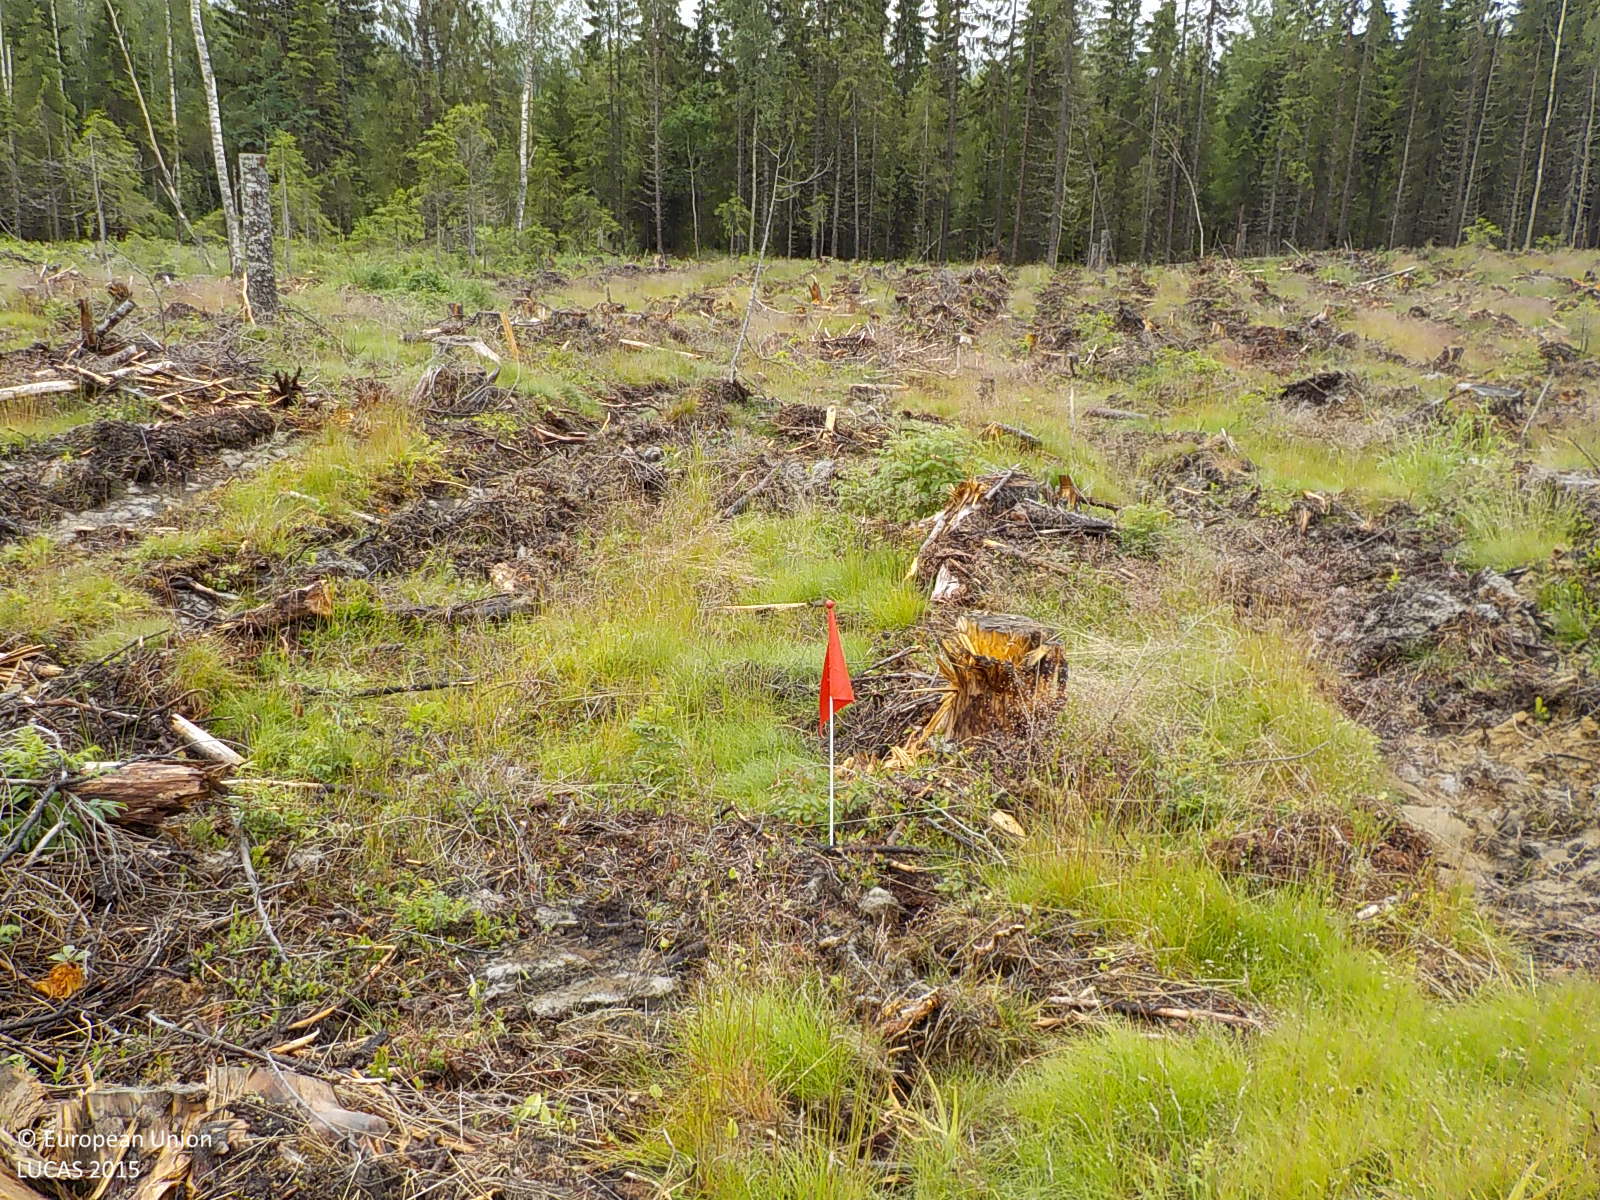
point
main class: Grassland
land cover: Grassland with sparse tree/shrub cover
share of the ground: 50 - 75 %
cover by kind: herbaceous plants 55 %, coniferous forest trees 5 %, shrubs 5 %, unconsolidated bare surface 5 %
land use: Forestry
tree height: < 5 m
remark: Clear cut
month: July
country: SE
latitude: 63.1437
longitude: 18.3312
